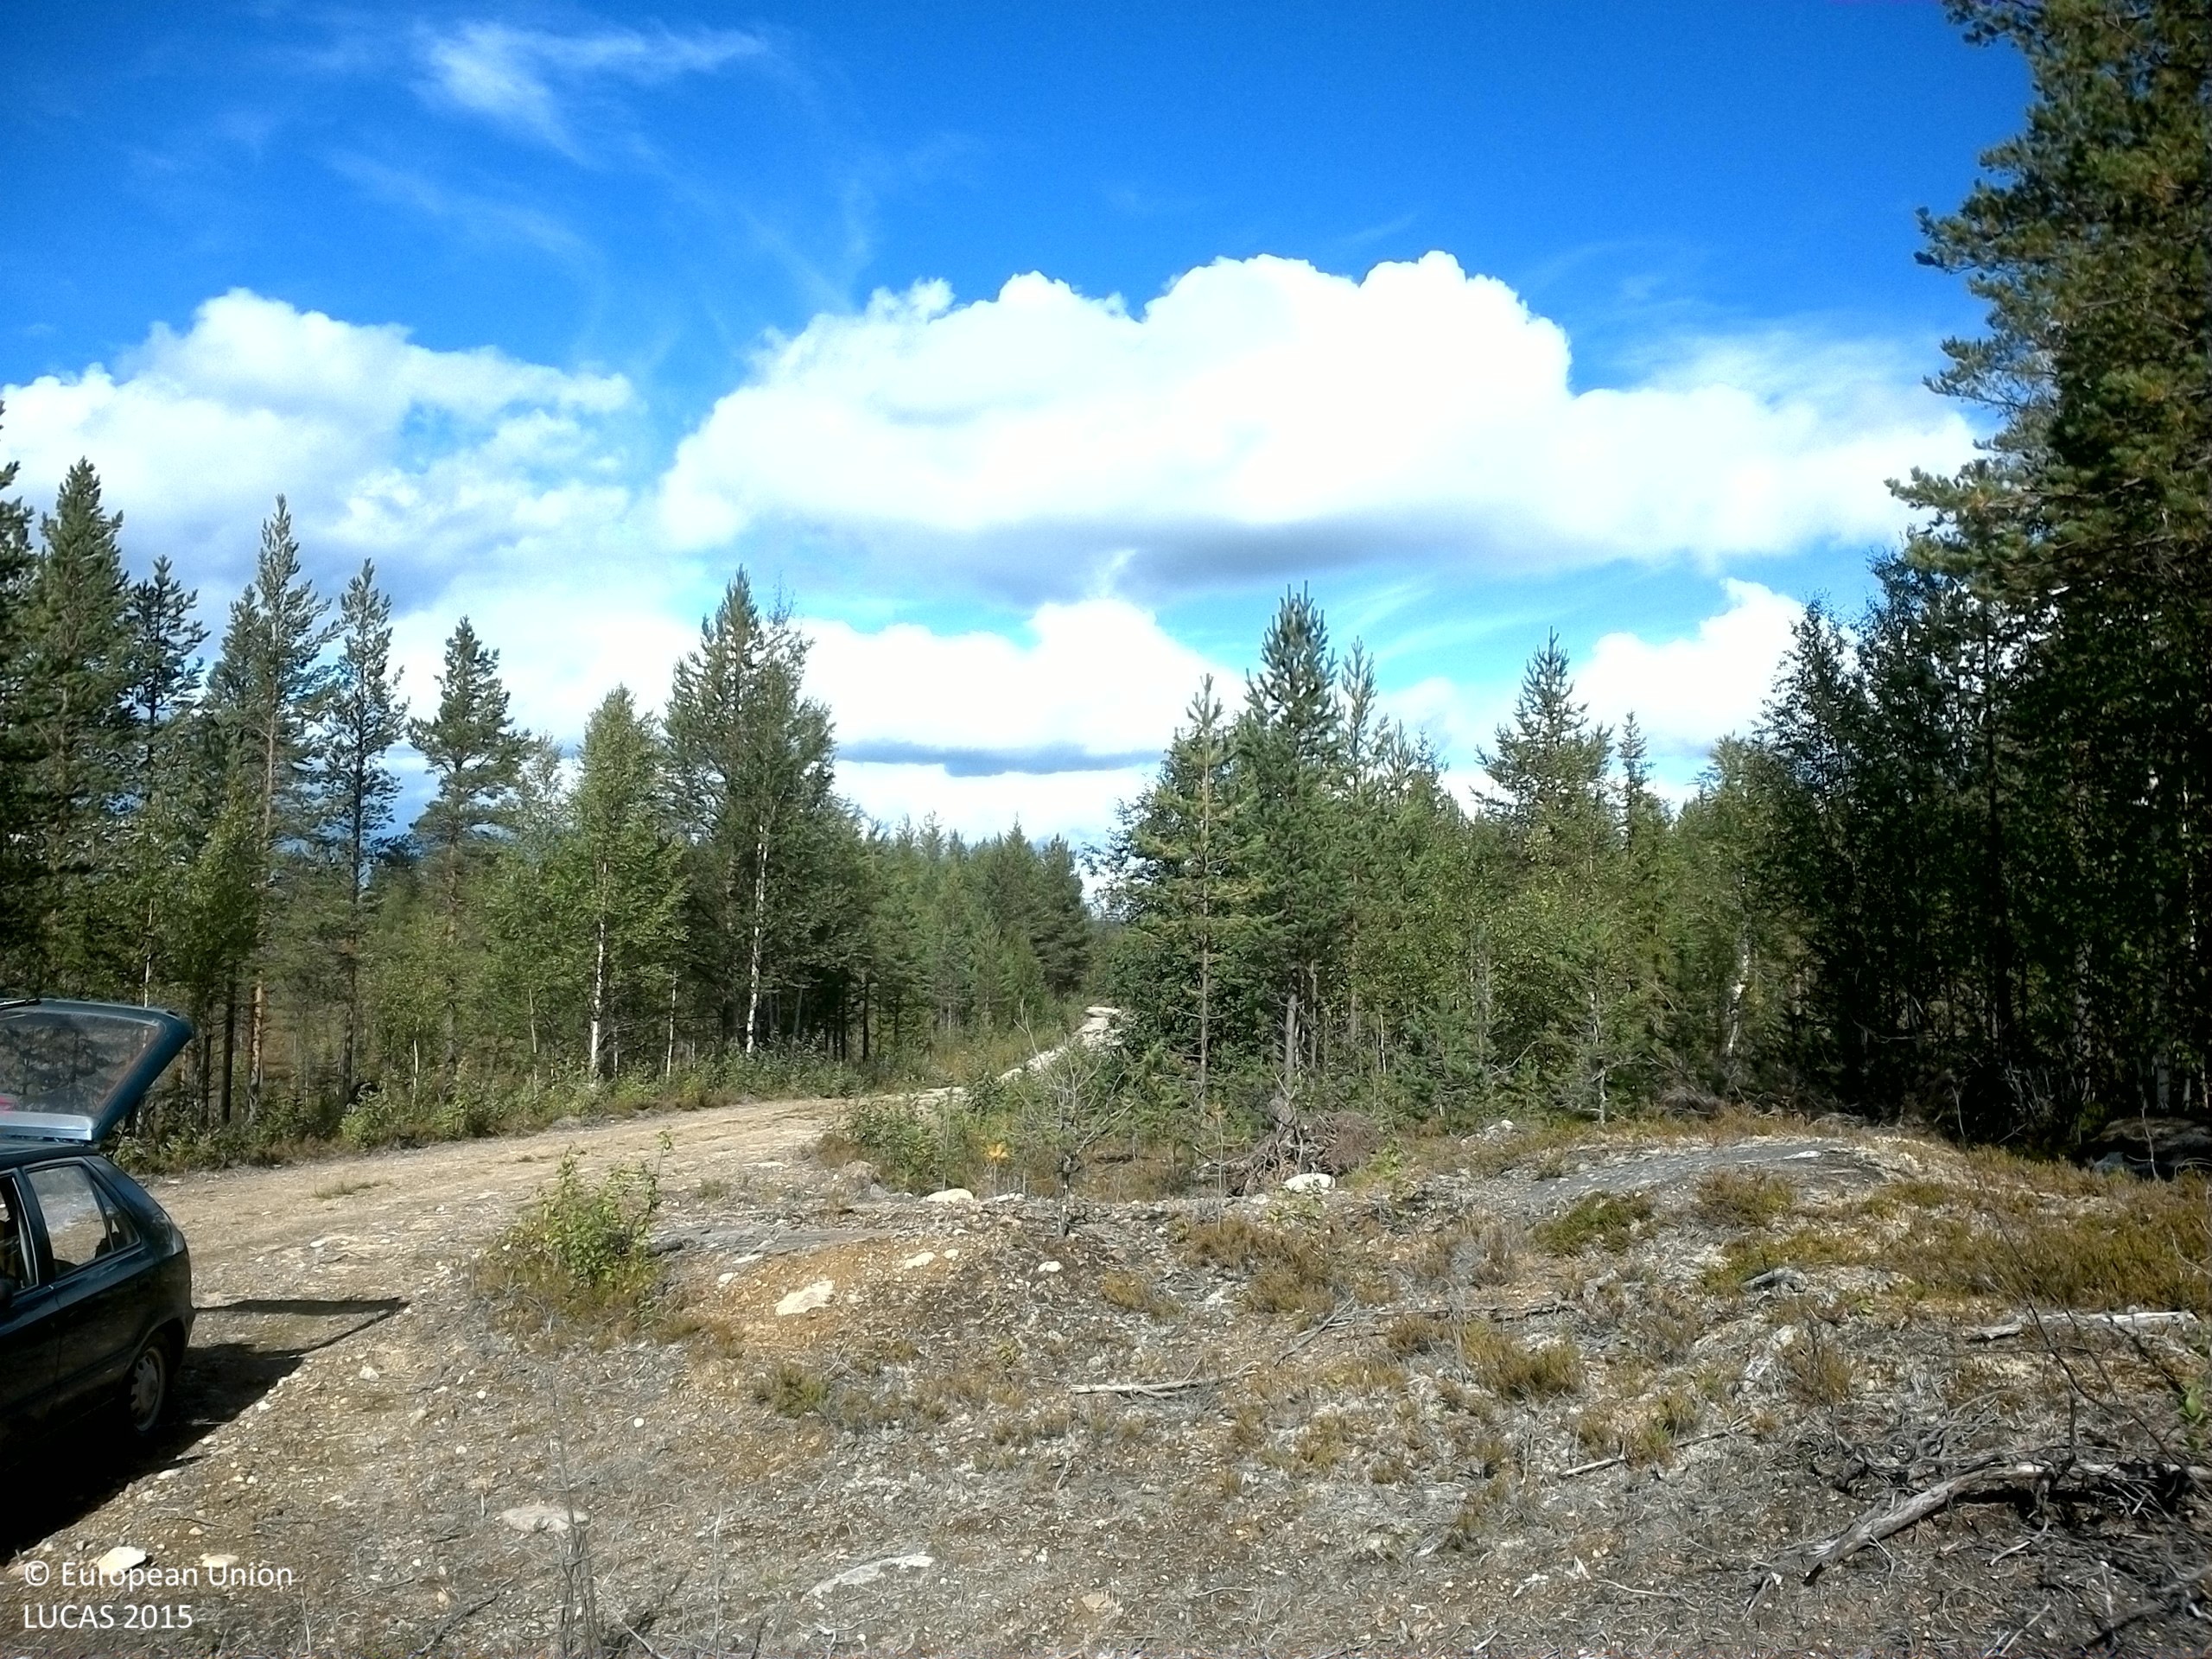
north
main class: Woodland
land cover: Pine dominated mixed woodland
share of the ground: 50 - 75 %
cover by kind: coniferous forest trees 30 %, broadleaved forest trees 30 %, shrubs 30 %, lichens and mosses 10 %
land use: Forestry
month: August
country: SE
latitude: 64.0080
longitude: 17.3945
